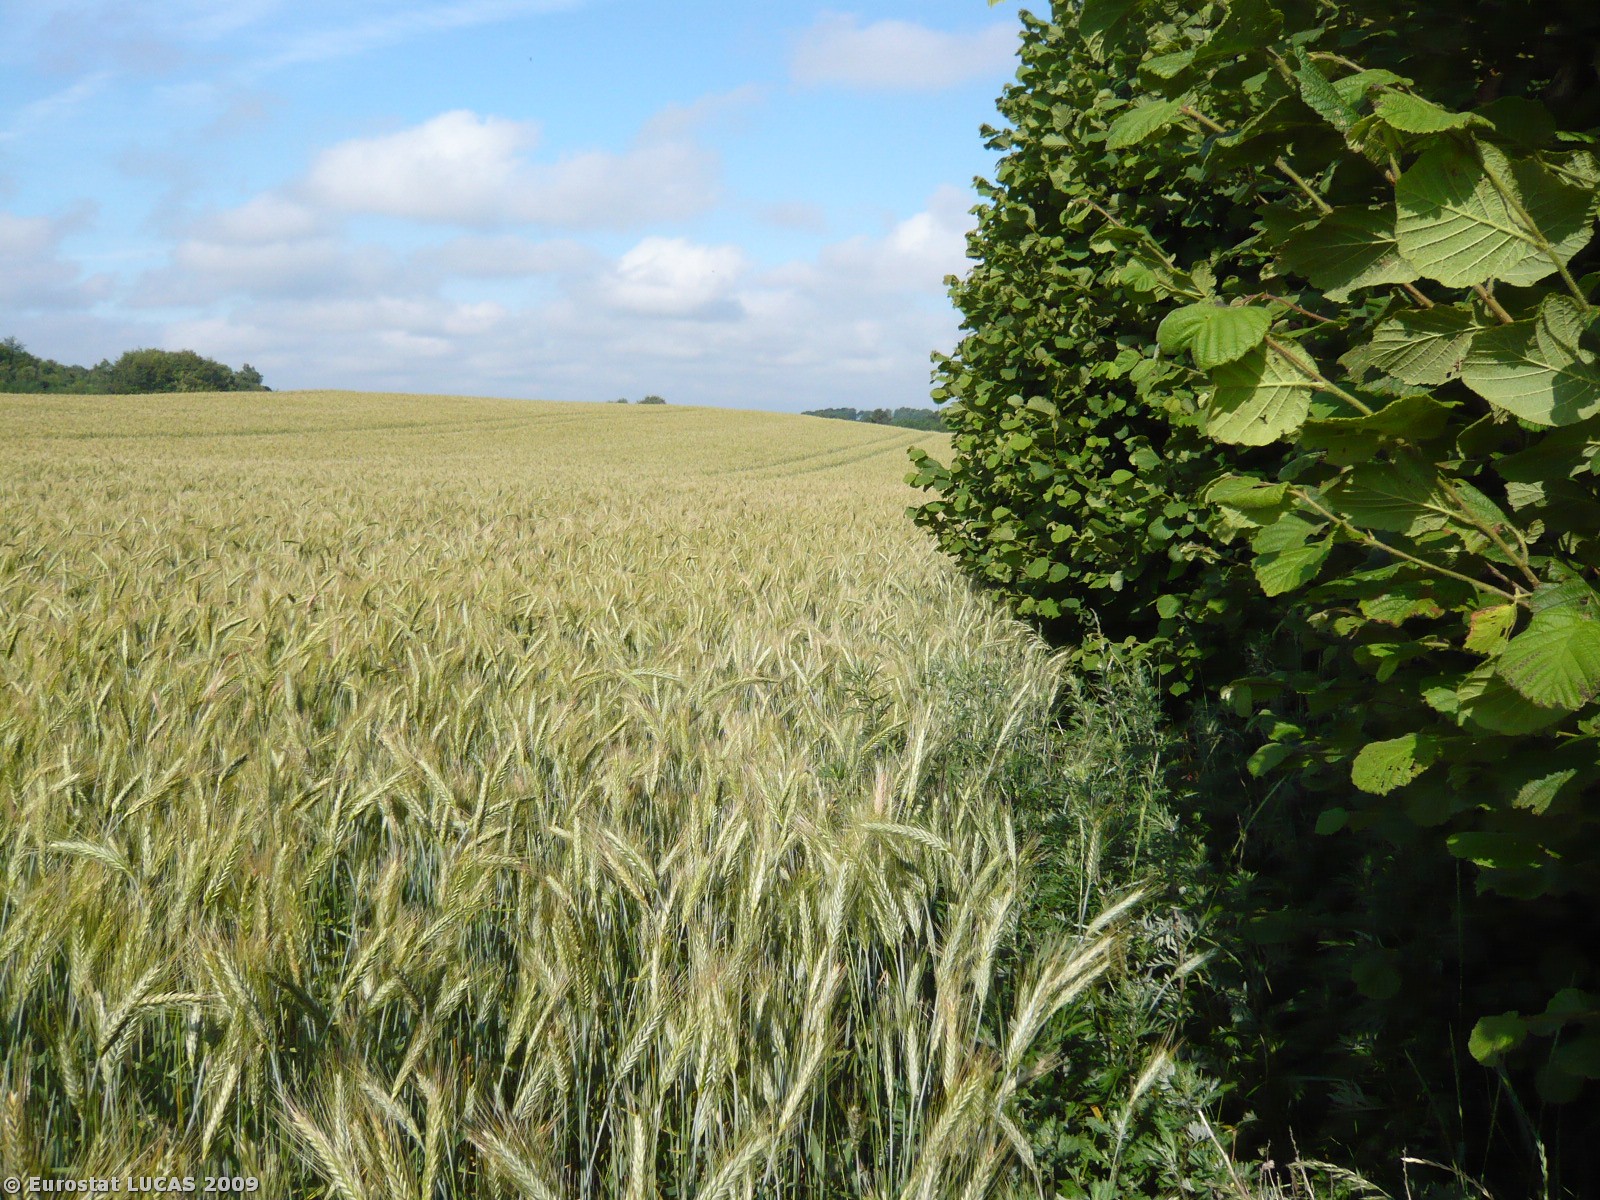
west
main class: Cropland
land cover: Triticale
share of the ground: > 75 %
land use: Agriculture (excluding fallow land and kitchen gardens)
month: June
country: DK
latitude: 55.2170
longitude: 10.1728
